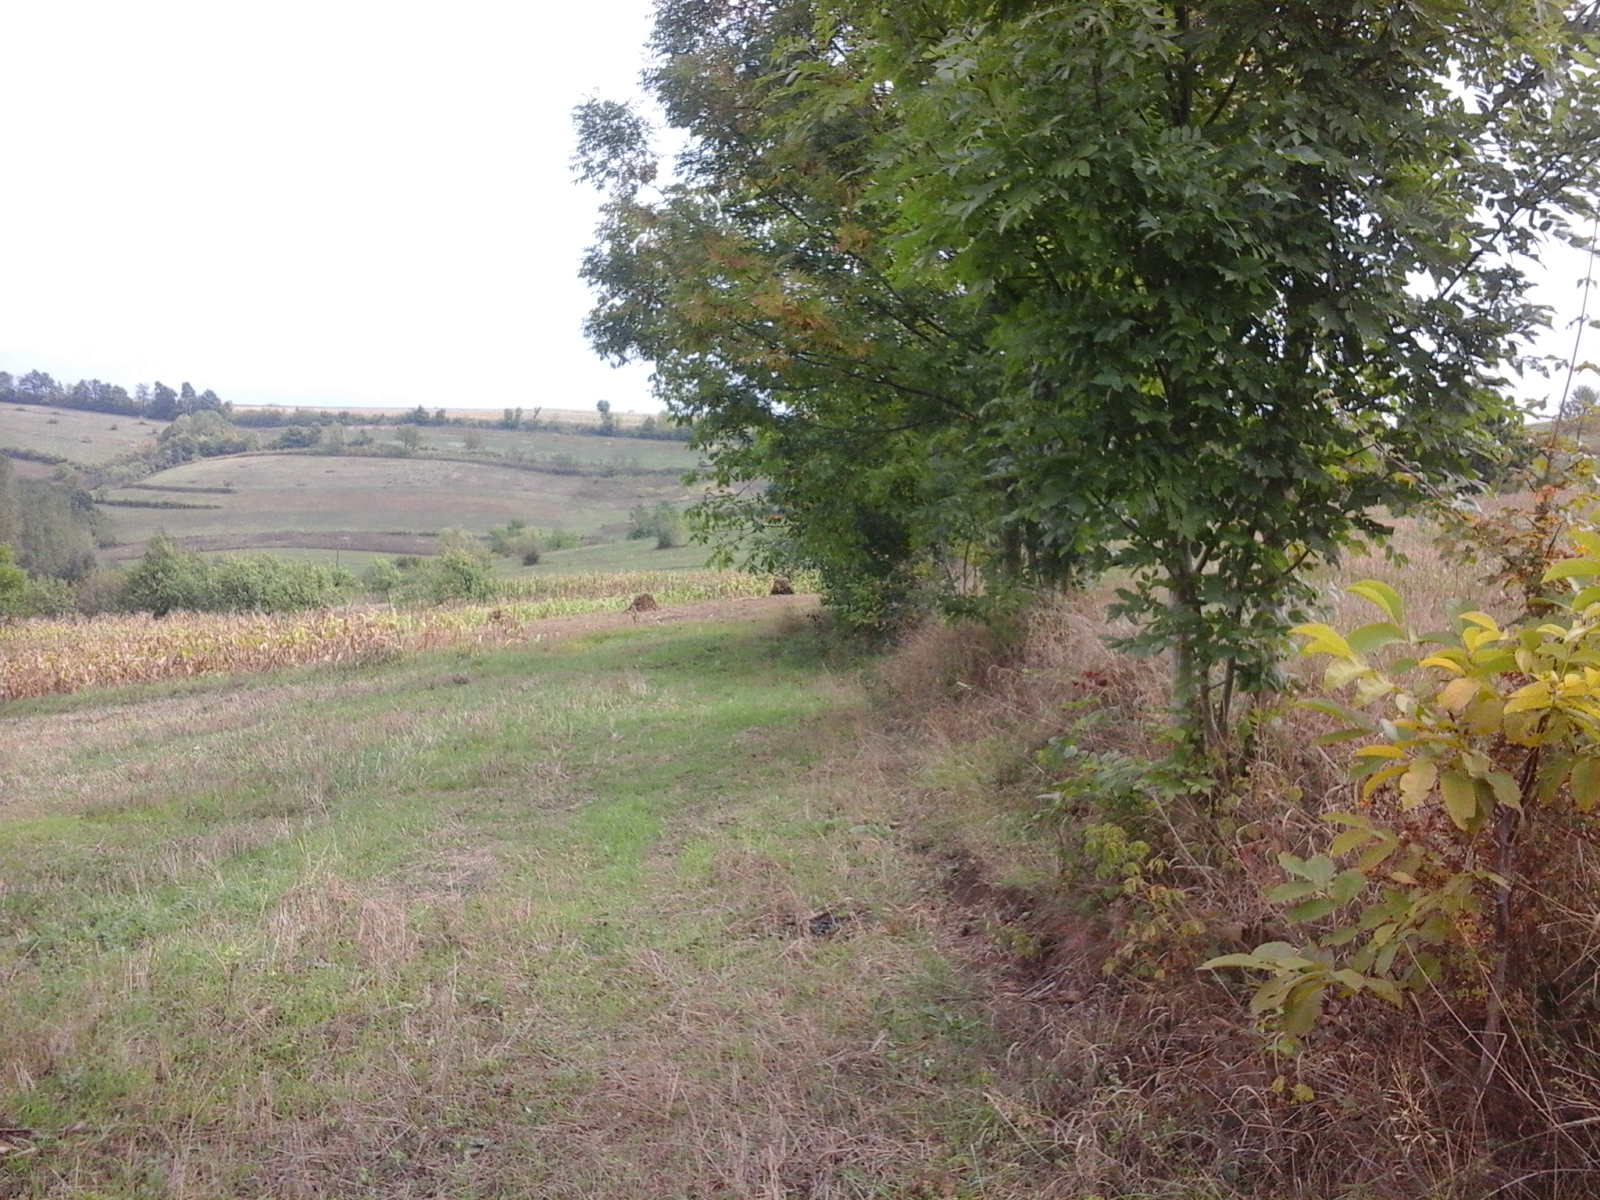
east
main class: Grassland
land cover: Grassland without tree/shrub cover
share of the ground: > 75 %
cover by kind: herbaceous plants 100 %
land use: Agriculture (excluding fallow land and kitchen gardens)
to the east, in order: Grassland without tree/shrub cover; Maize; Grassland without tree/shrub cover; Maize; Grassland without tree/shrub cover; Common wheat; Lucerne; Grassland without tree/shrub cover; Single bushes/trees; Grassland without tree/shrub cover
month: September
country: RO
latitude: 46.7029
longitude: 22.2251
